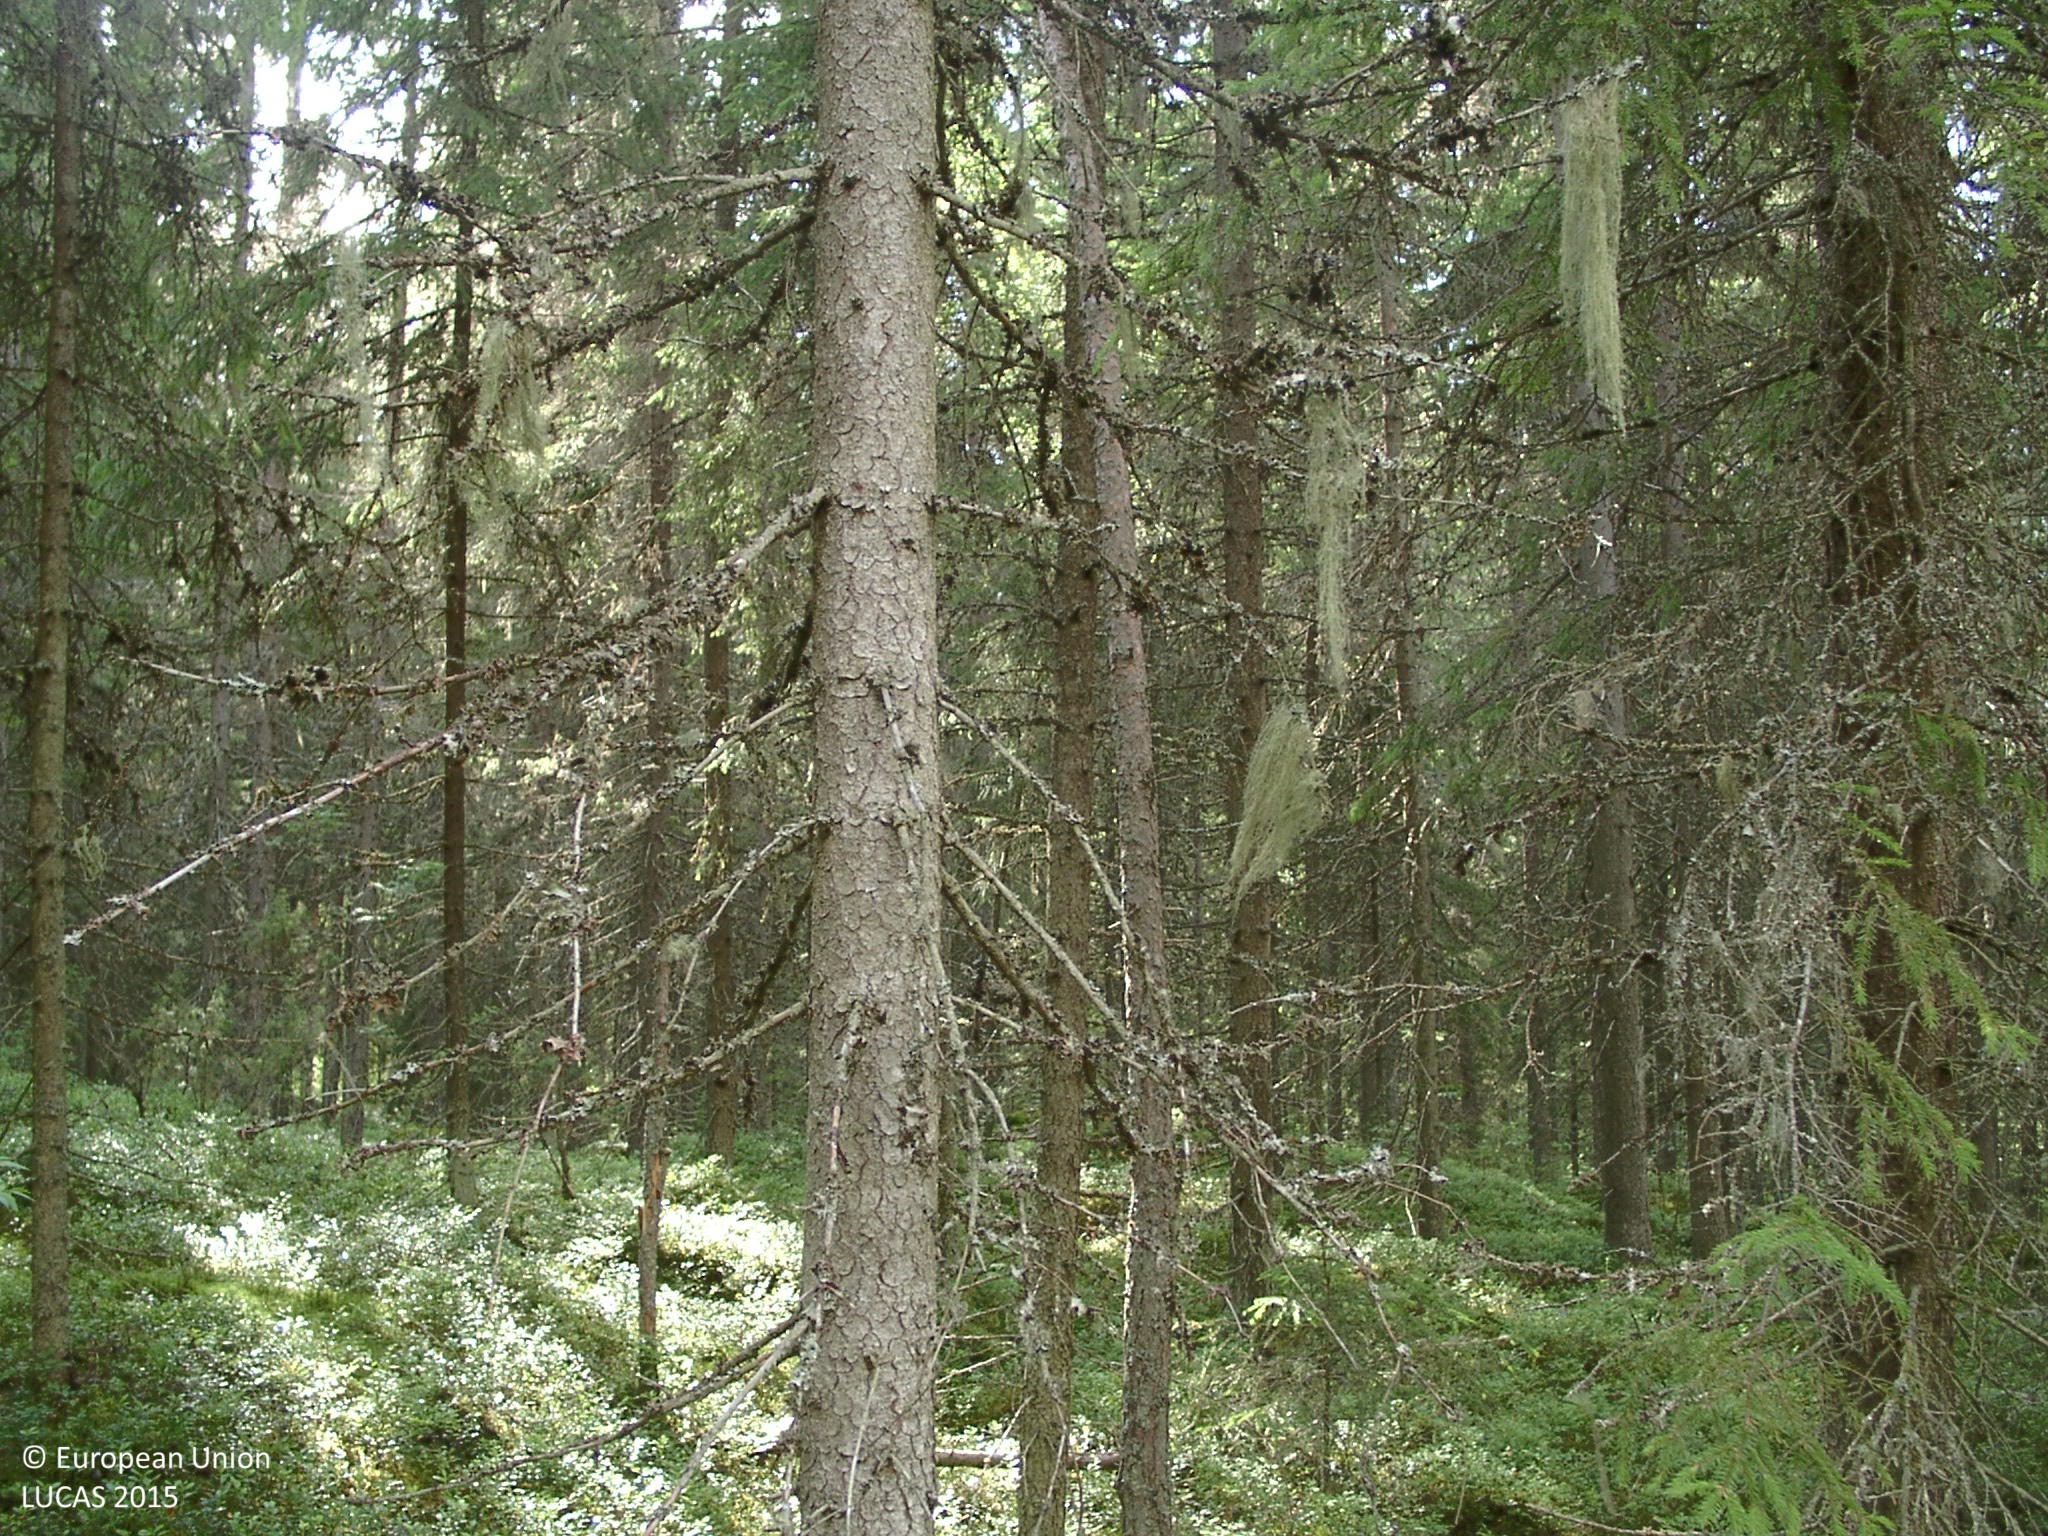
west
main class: Woodland
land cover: Other coniferous woodland
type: boreal forest
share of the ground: 50 - 75 %
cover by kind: coniferous forest trees 55 %, shrubs 25 %, broadleaved forest trees 15 %, lichens and mosses 5 %
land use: Forestry
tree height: > 5 m
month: July
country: FI
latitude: 62.2242
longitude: 25.1679
